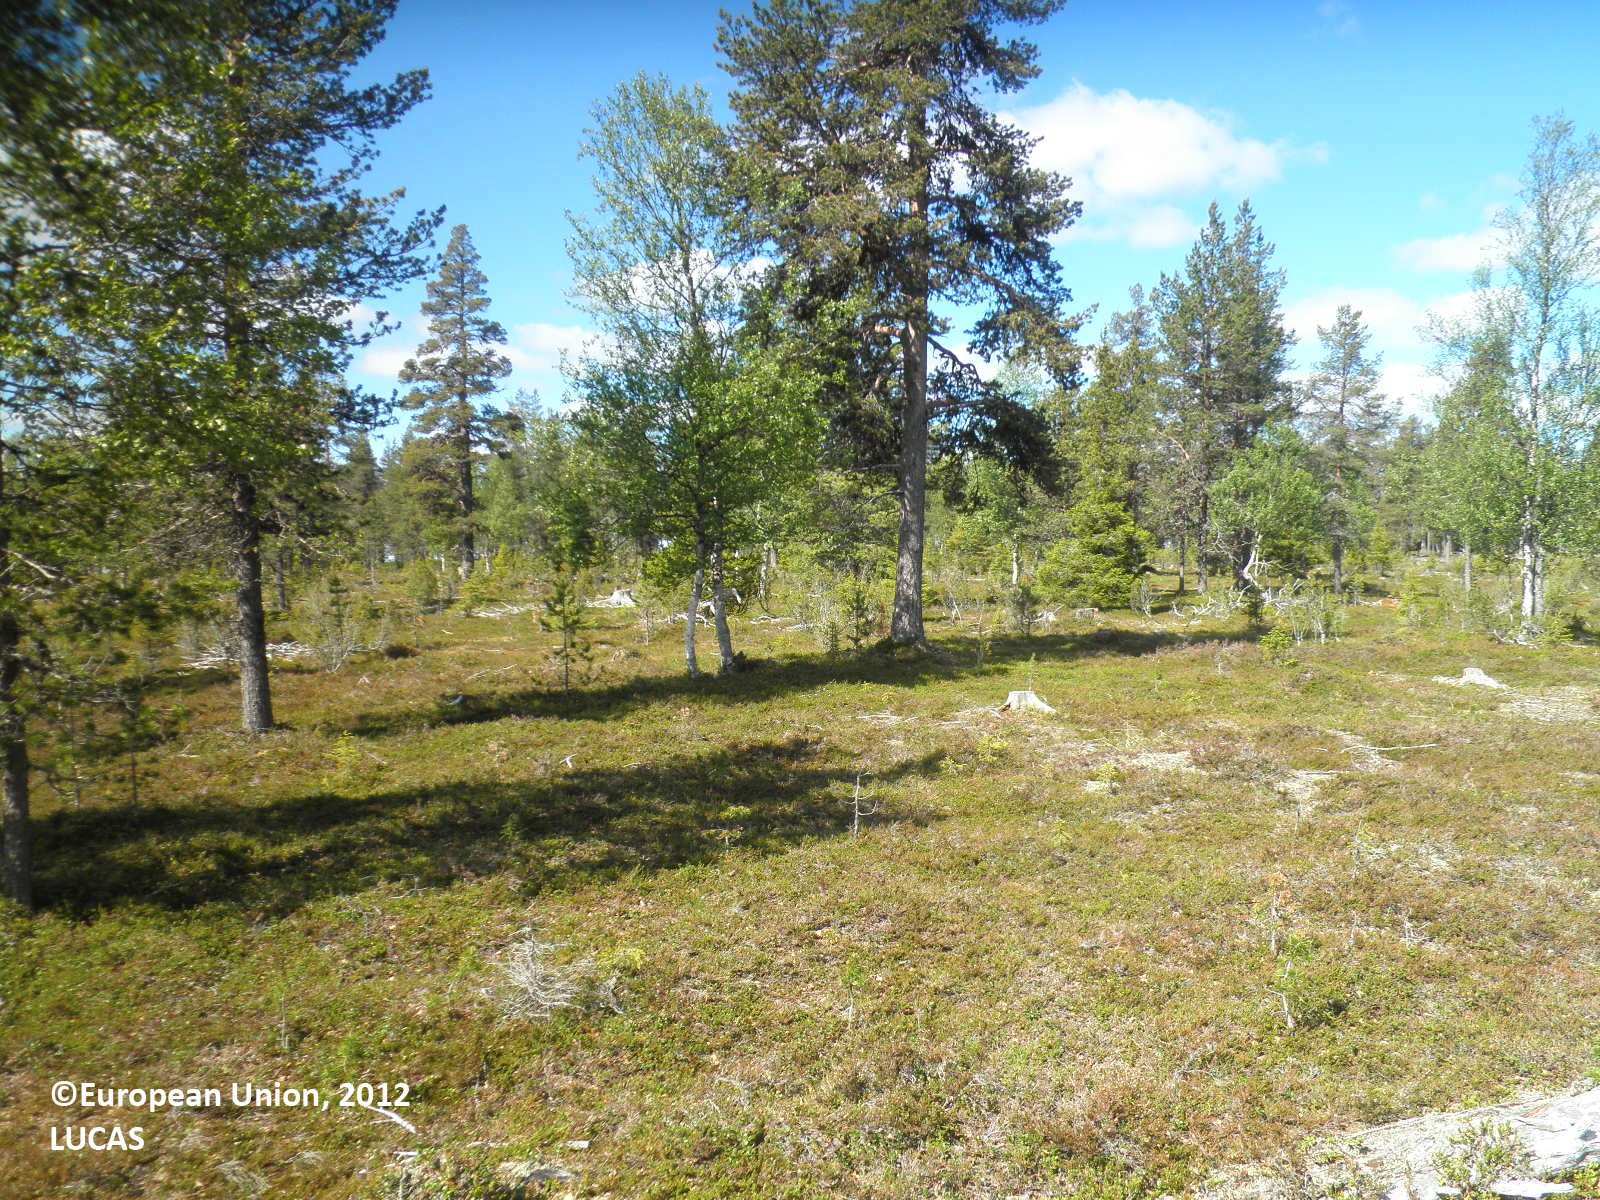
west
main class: Woodland
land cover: Pine dominated mixed woodland
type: boreal forest
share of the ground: 10 - 25 %
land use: Forestry
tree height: > 5 m
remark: Harvested field
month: June
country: FI
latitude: 68.2858
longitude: 26.9007
